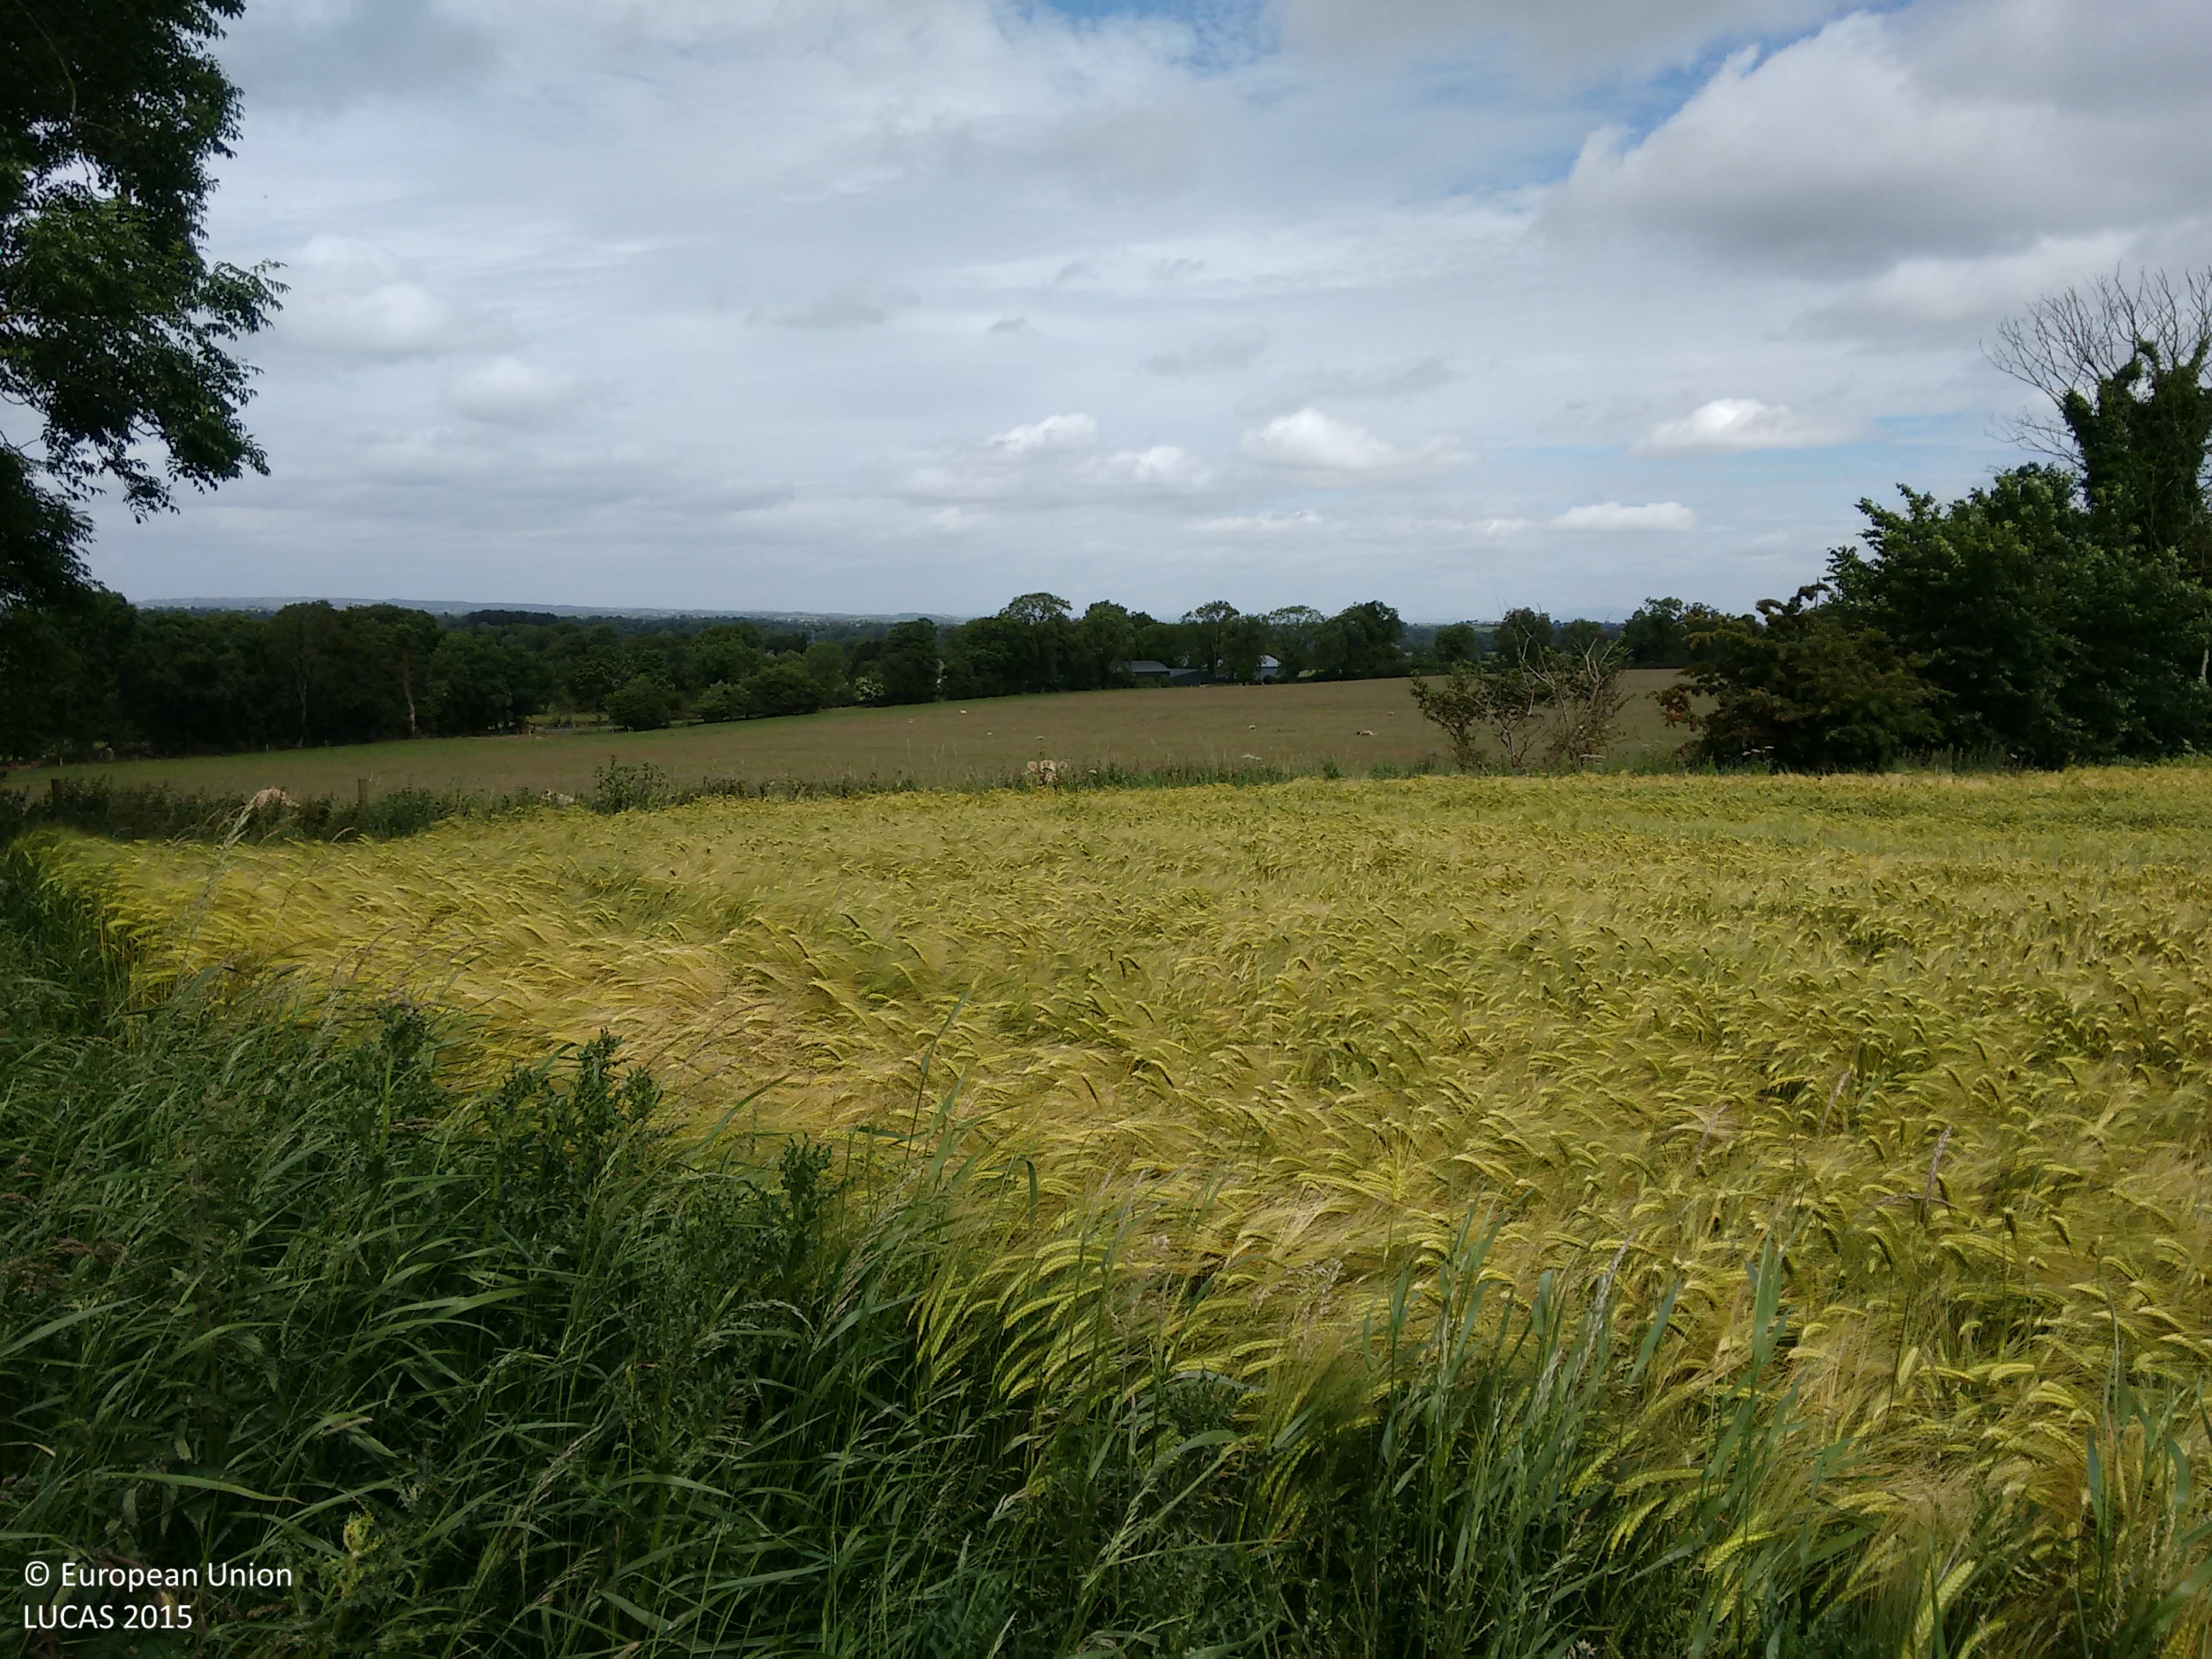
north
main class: Grassland
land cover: Grassland without tree/shrub cover
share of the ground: > 75 %
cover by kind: herbaceous plants 100 %
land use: Agriculture (excluding fallow land and kitchen gardens)
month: June
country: IE
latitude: 53.7418
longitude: -6.6730
